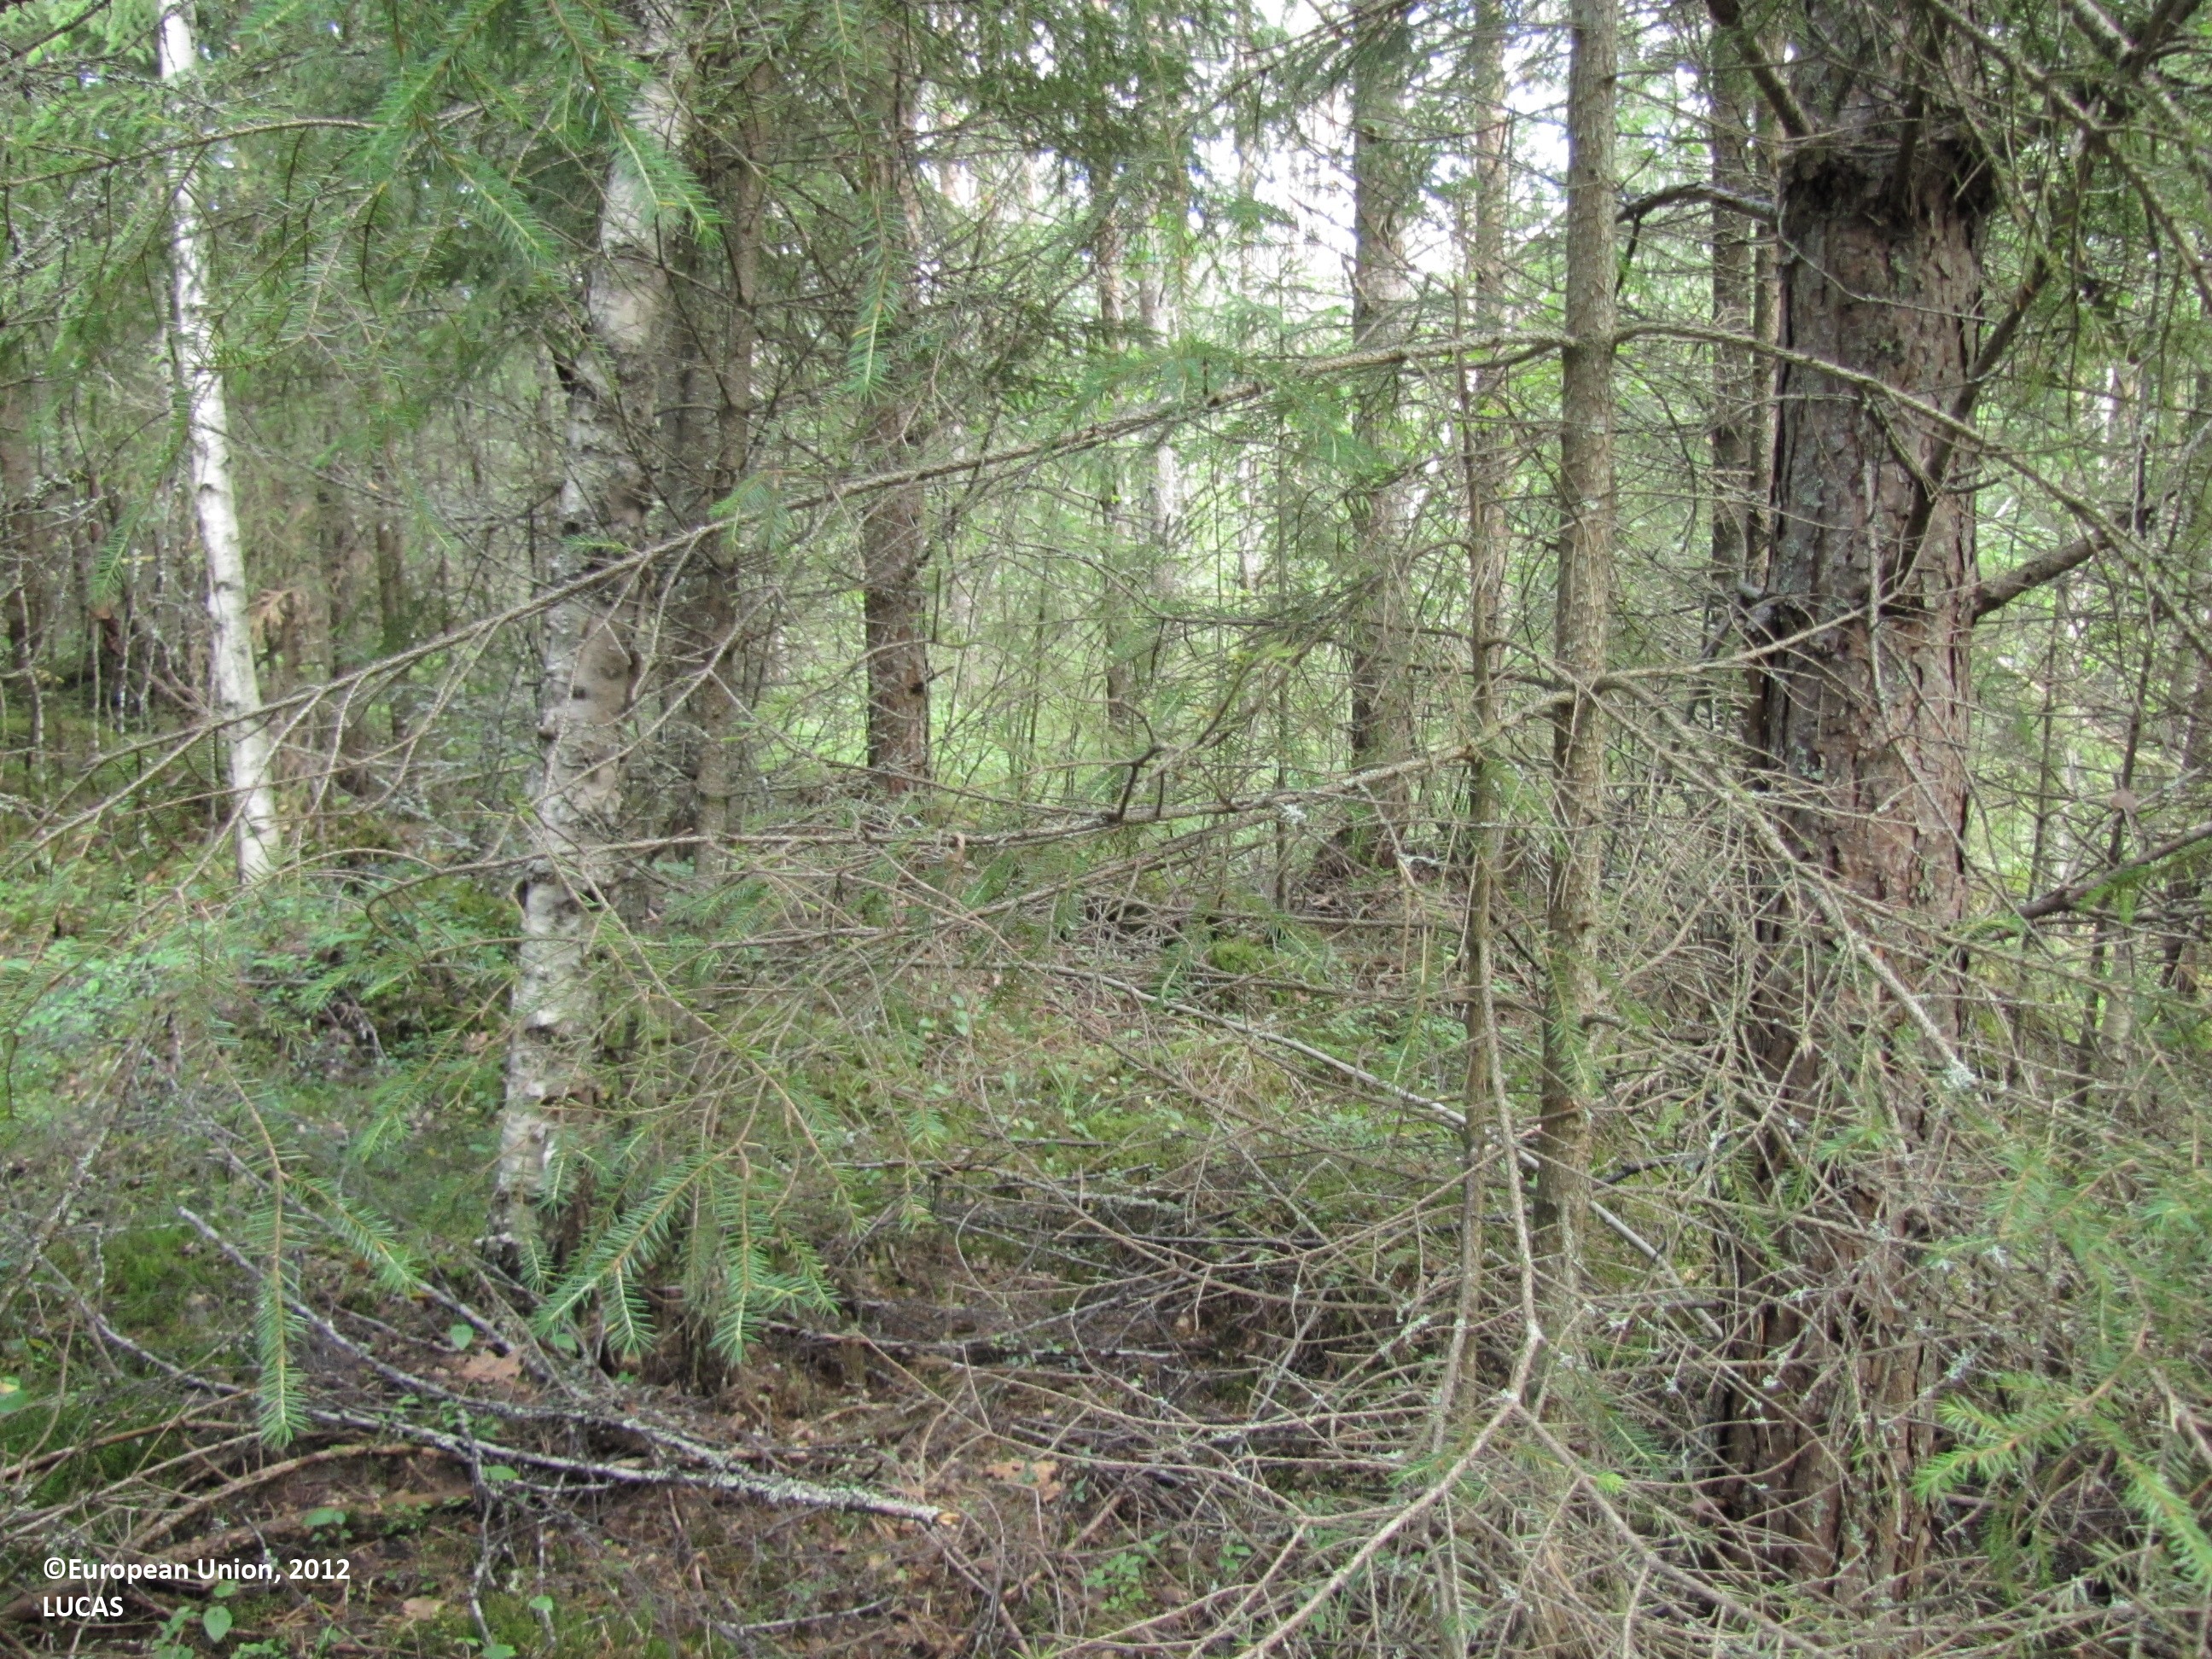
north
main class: Woodland
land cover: Spruce dominated mixed woodland
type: boreal forest
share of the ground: > 75 %
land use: Forestry
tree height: > 5 m
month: July
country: FI
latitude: 62.0919
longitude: 23.3049
